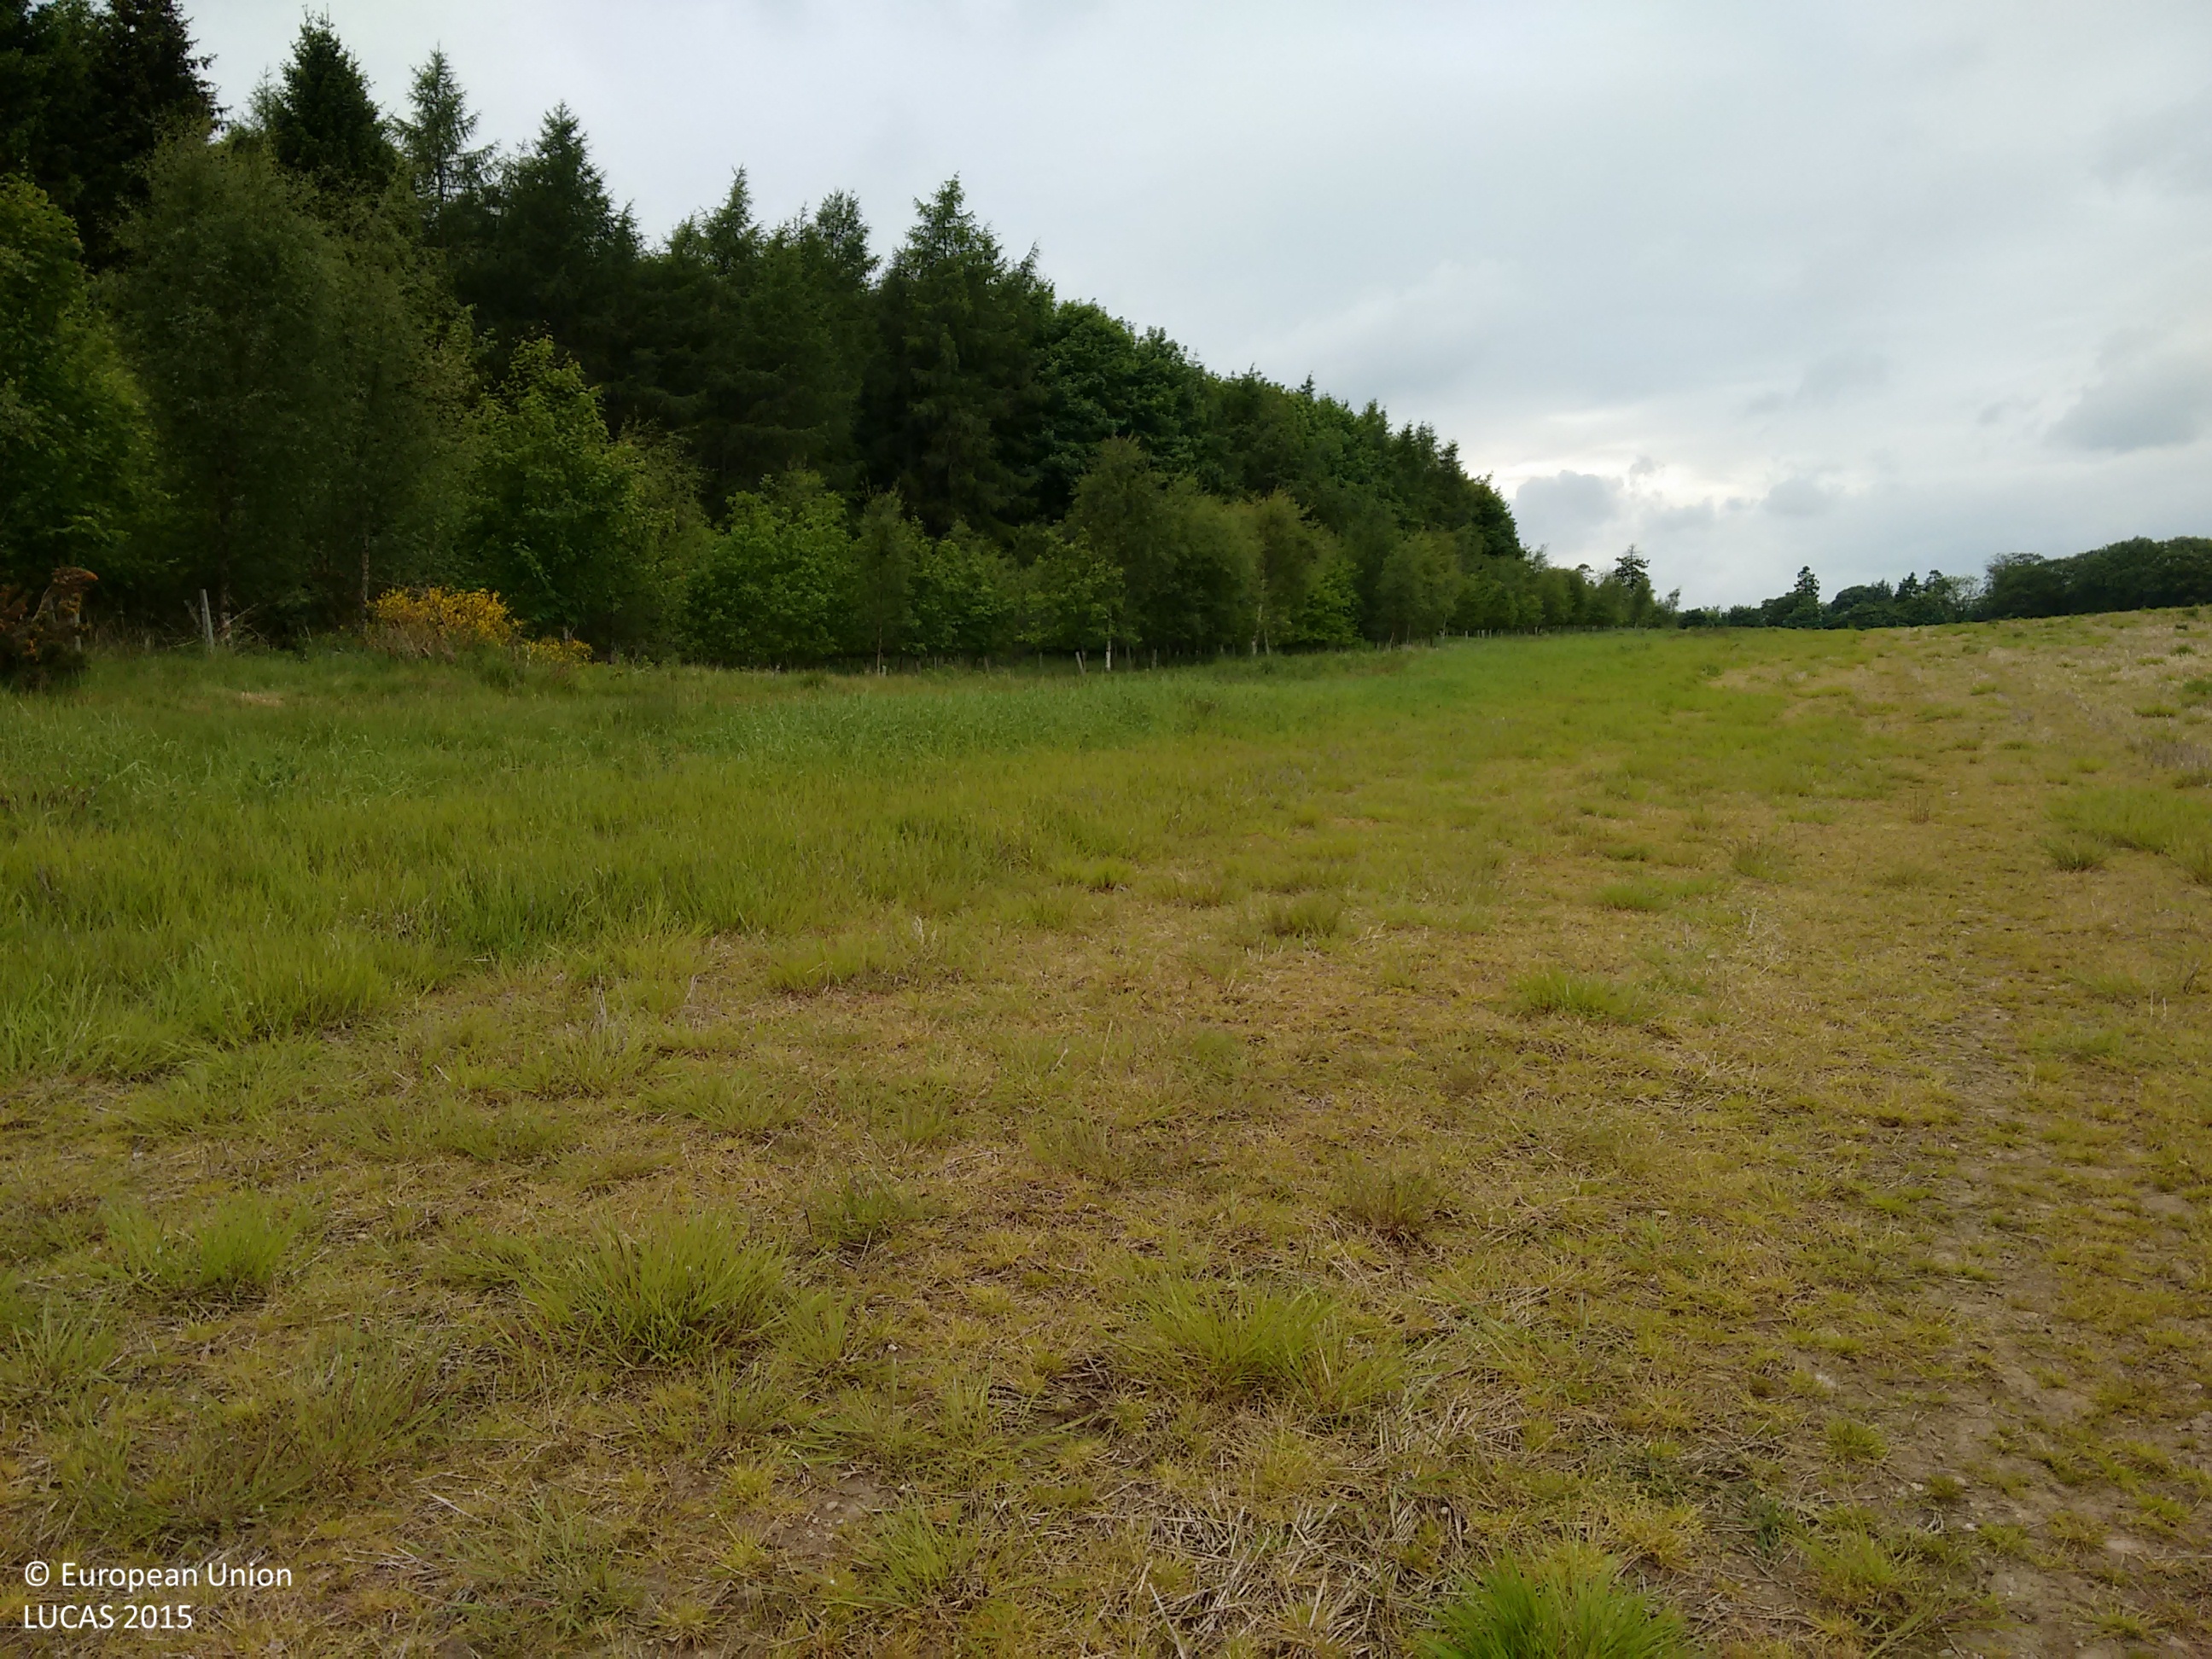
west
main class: Grassland
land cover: Spontaneously vegetated surfaces
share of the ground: > 75 %
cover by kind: herbaceous plants 85 %, unconsolidated bare surface 15 %
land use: Fallow land
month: June
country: GB
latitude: 56.4524
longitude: -3.3609
